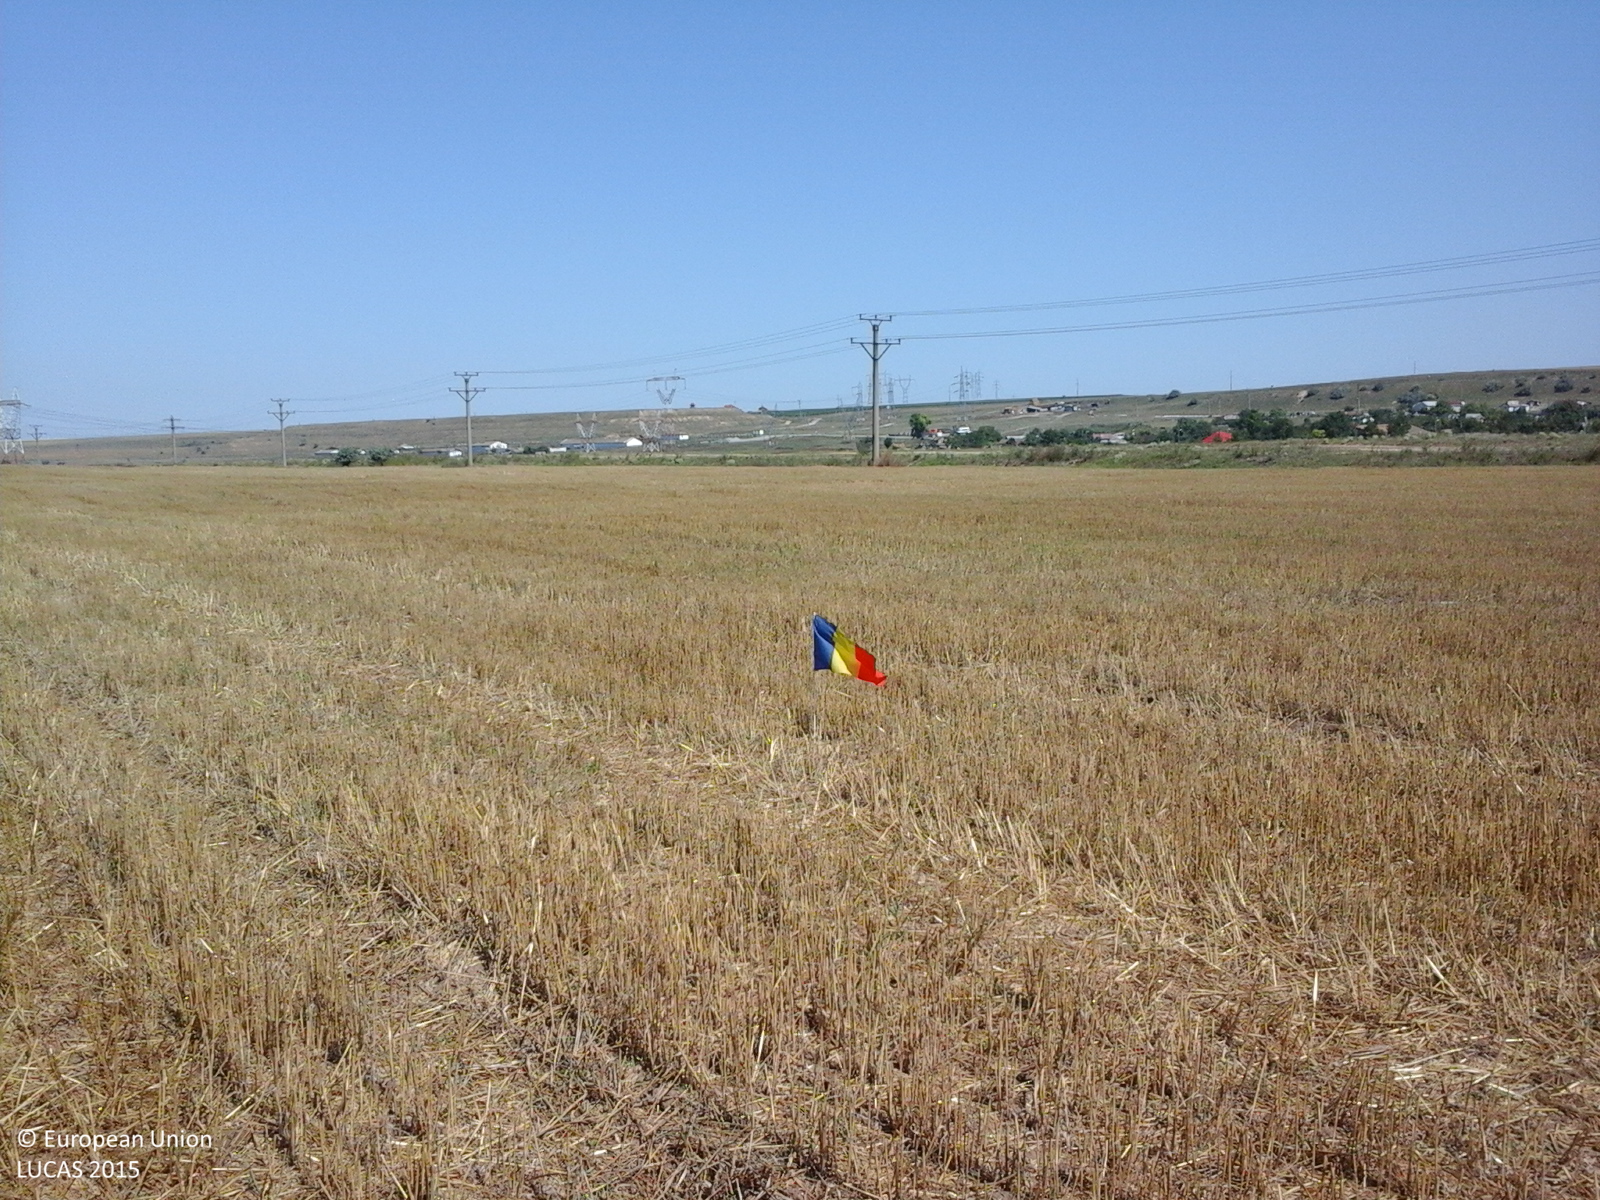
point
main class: Cropland
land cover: Common wheat
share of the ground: > 75 %
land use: Agriculture (excluding fallow land and kitchen gardens)
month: August
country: RO
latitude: 44.2322
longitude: 28.4348
